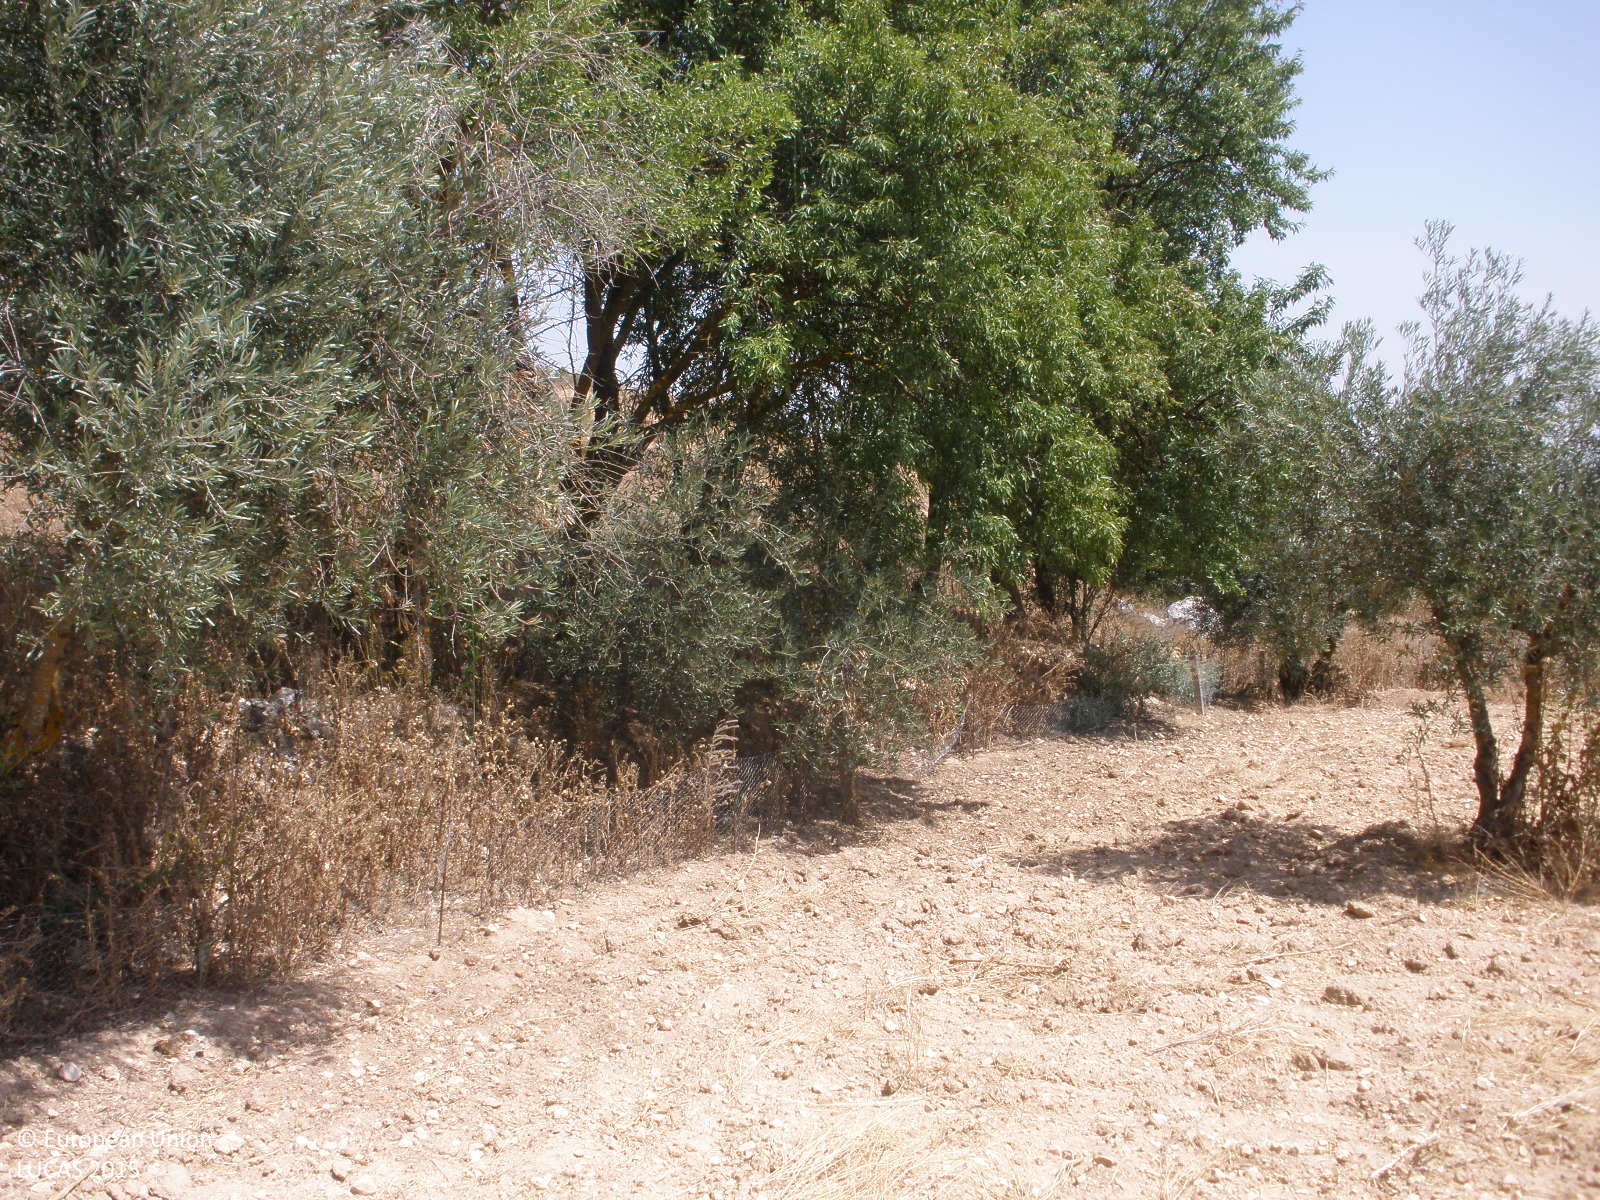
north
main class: Cropland
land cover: Olive groves
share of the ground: 25 - 50 %
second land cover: Other bare soil
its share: > 75 %
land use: Agriculture (excluding fallow land and kitchen gardens)
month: July
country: ES
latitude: 39.9909
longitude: -3.4859
